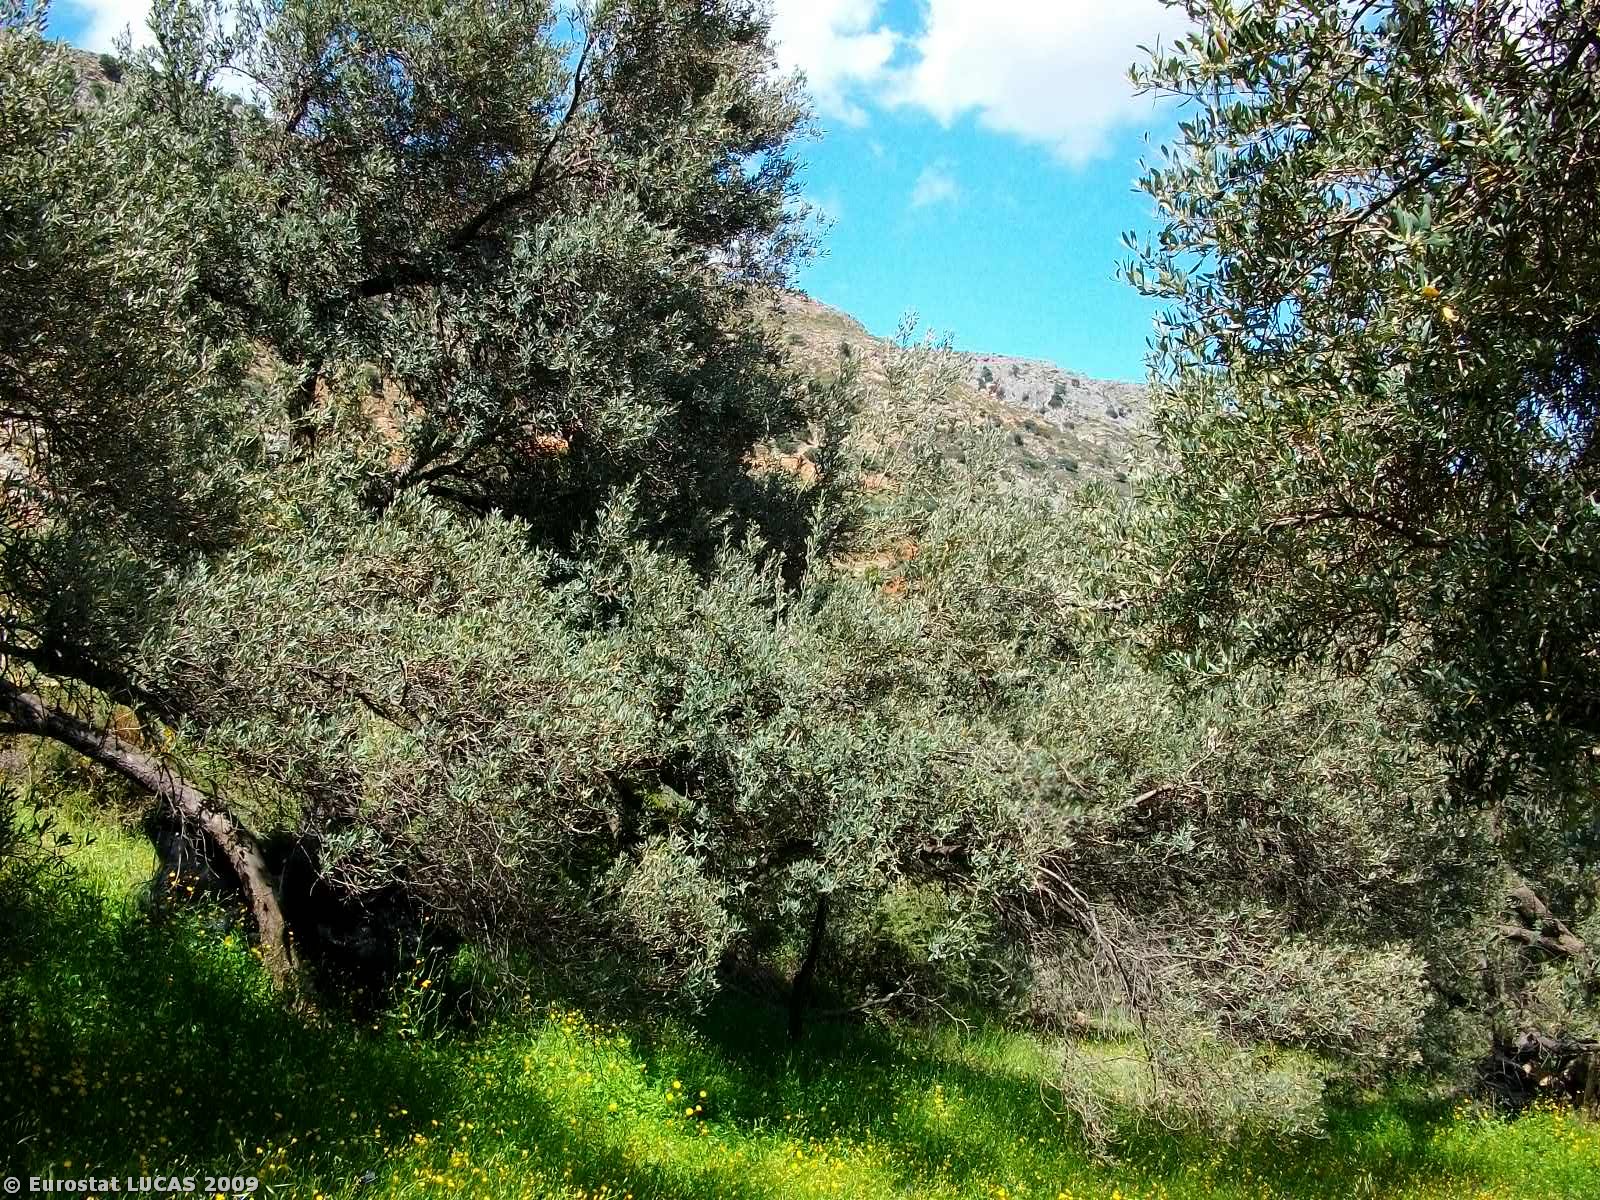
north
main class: Cropland
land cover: Olive groves
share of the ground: 50 - 75 %
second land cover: Grassland with sparse tree/shrub cover
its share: > 75 %
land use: Agriculture (excluding fallow land and kitchen gardens)
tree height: < 5 m
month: April
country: GR
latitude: 35.2973
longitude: 25.0016
